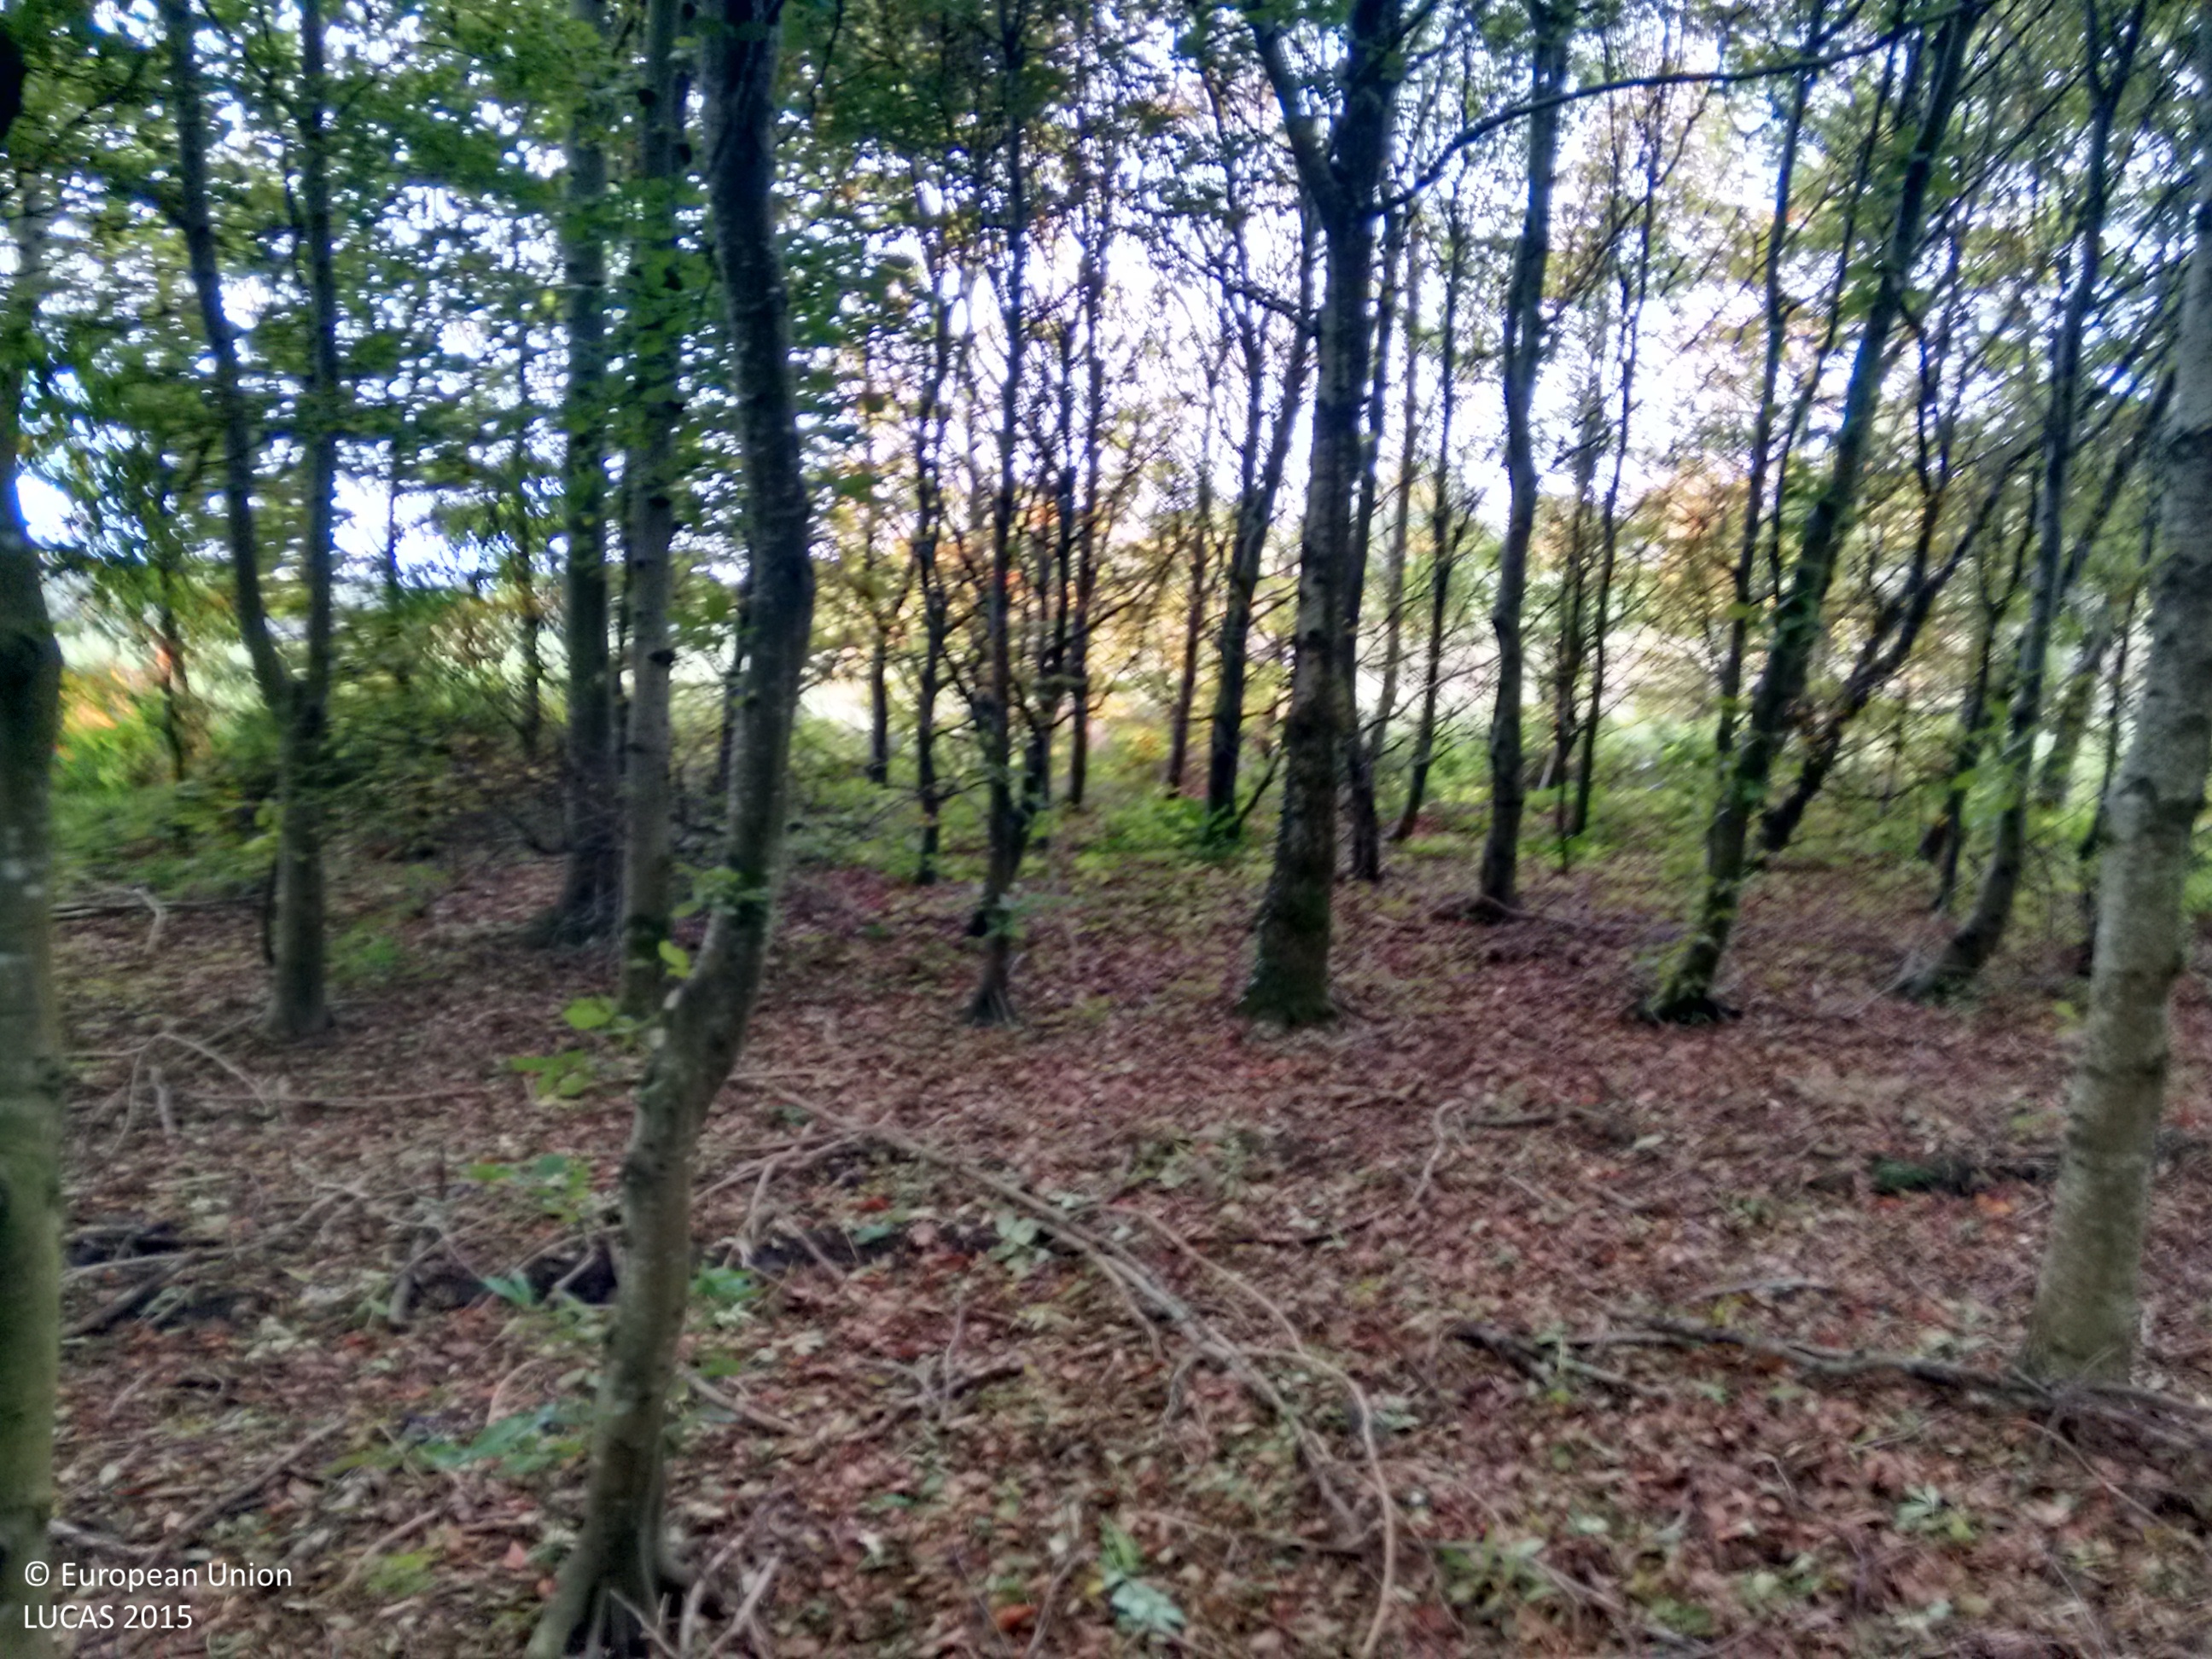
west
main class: Woodland
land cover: Broadleaved woodland
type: mesophytic deciduous forest
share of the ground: > 75 %
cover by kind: broadleaved forest trees 100 %
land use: Forestry
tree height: > 5 m
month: October
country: IE
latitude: 53.1033
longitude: -7.7778
